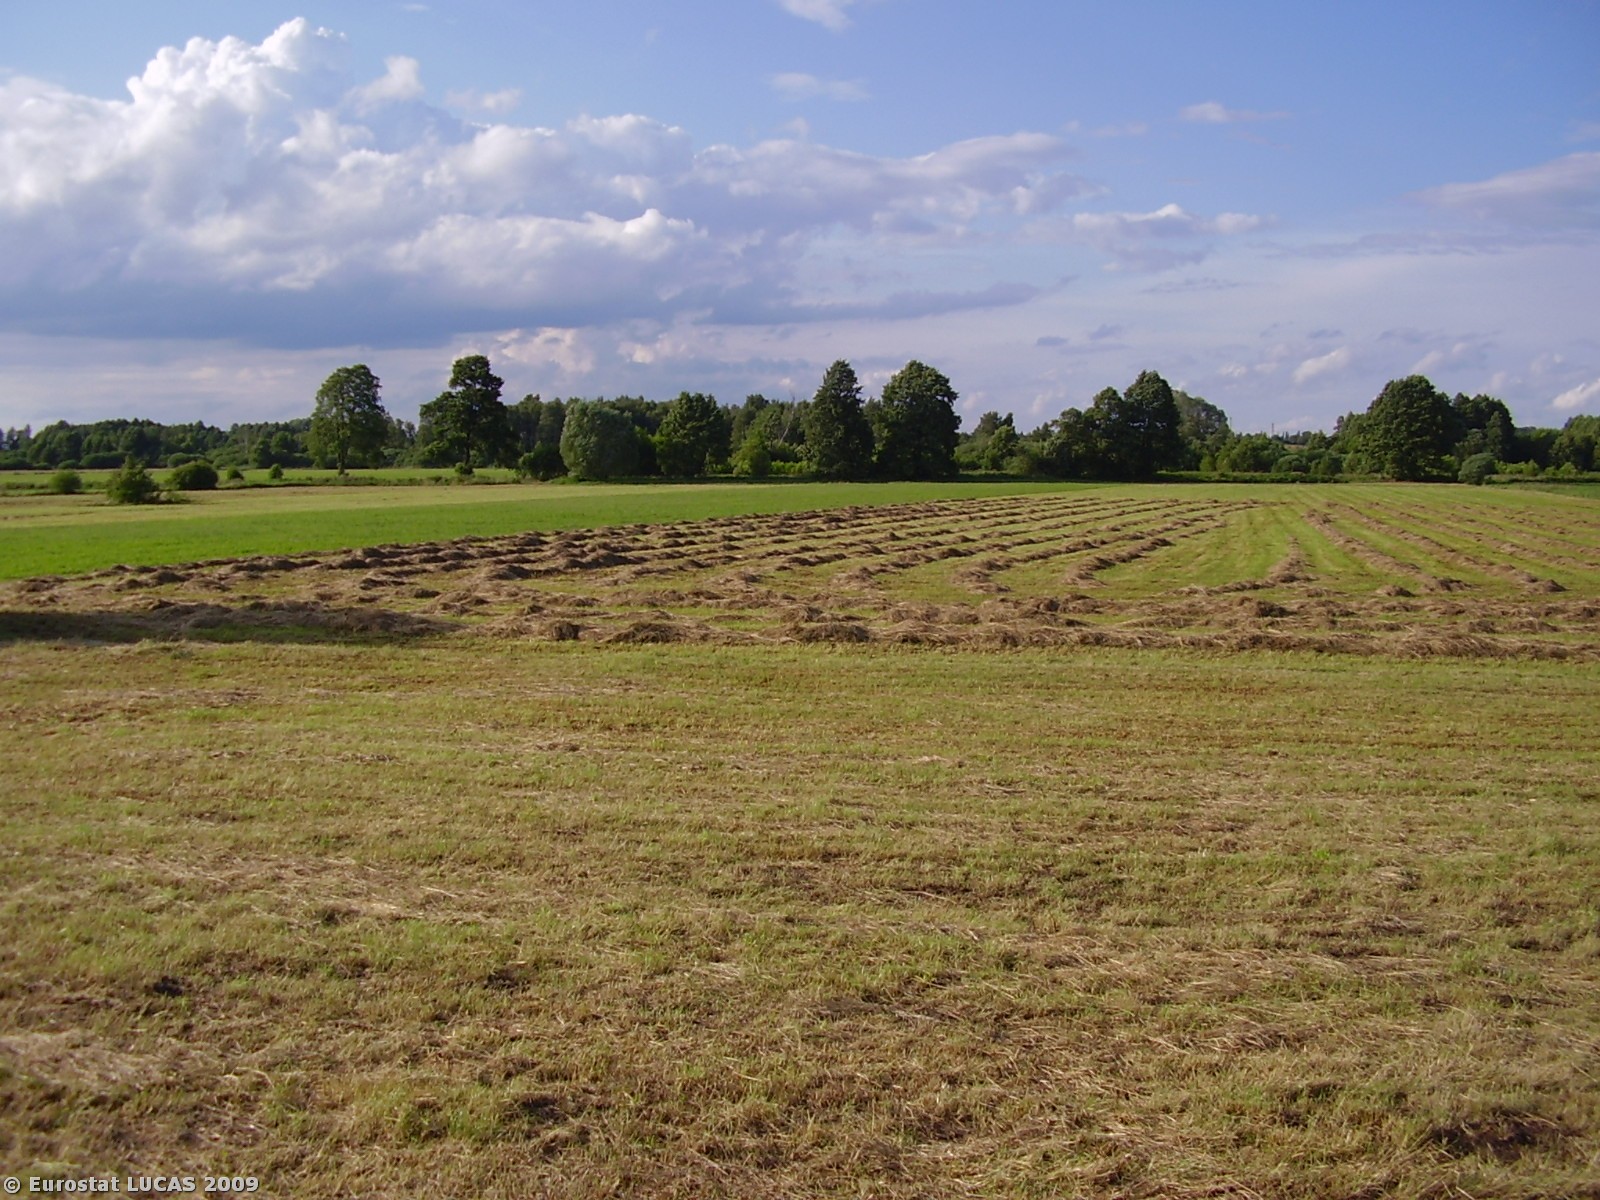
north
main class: Cropland
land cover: Mixed cereals for fodder
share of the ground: > 75 %
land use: Agriculture (excluding fallow land and kitchen gardens)
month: July
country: PL
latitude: 51.2602
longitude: 17.9690
